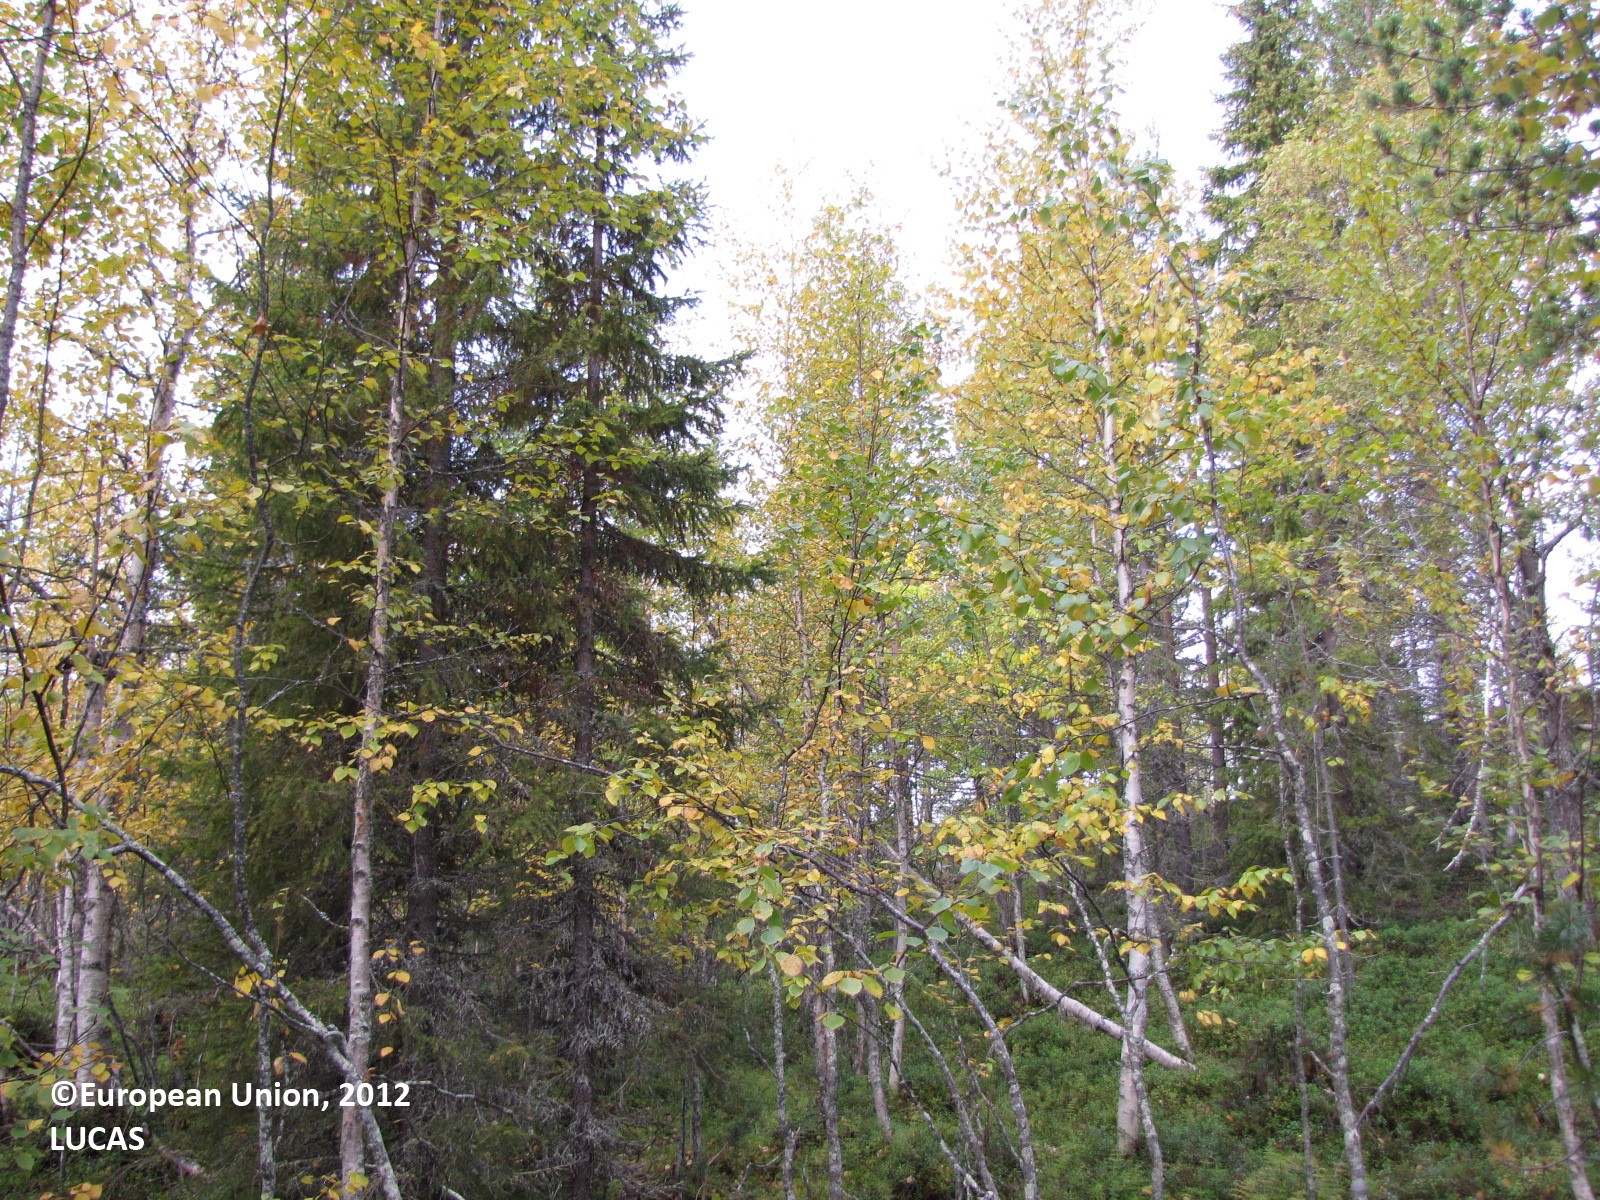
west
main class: Woodland
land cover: Spruce dominated mixed woodland
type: boreal forest
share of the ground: 25 - 50 %
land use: Forestry
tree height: > 5 m
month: September
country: FI
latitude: 67.3608
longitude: 25.2006
